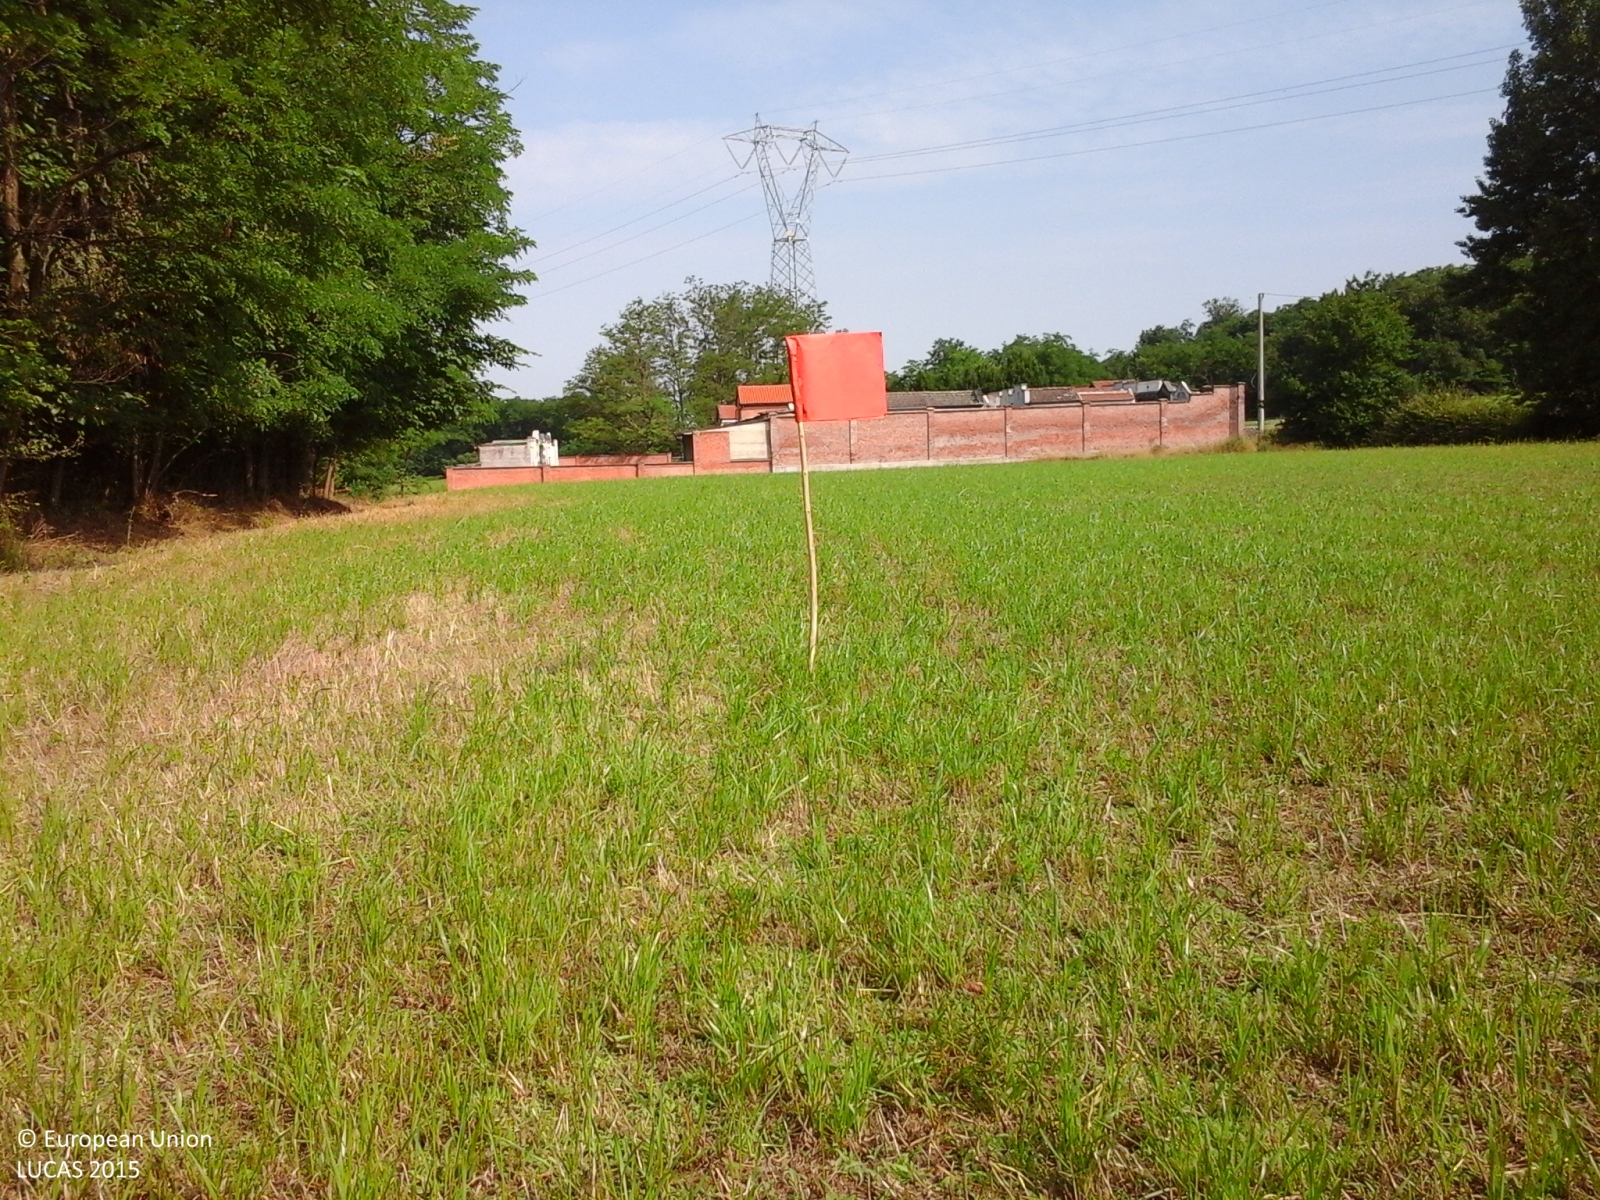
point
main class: Cropland
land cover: Temporary grasslands
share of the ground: > 75 %
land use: Agriculture (excluding fallow land and kitchen gardens)
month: June
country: IT
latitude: 44.7395
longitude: 8.7271
